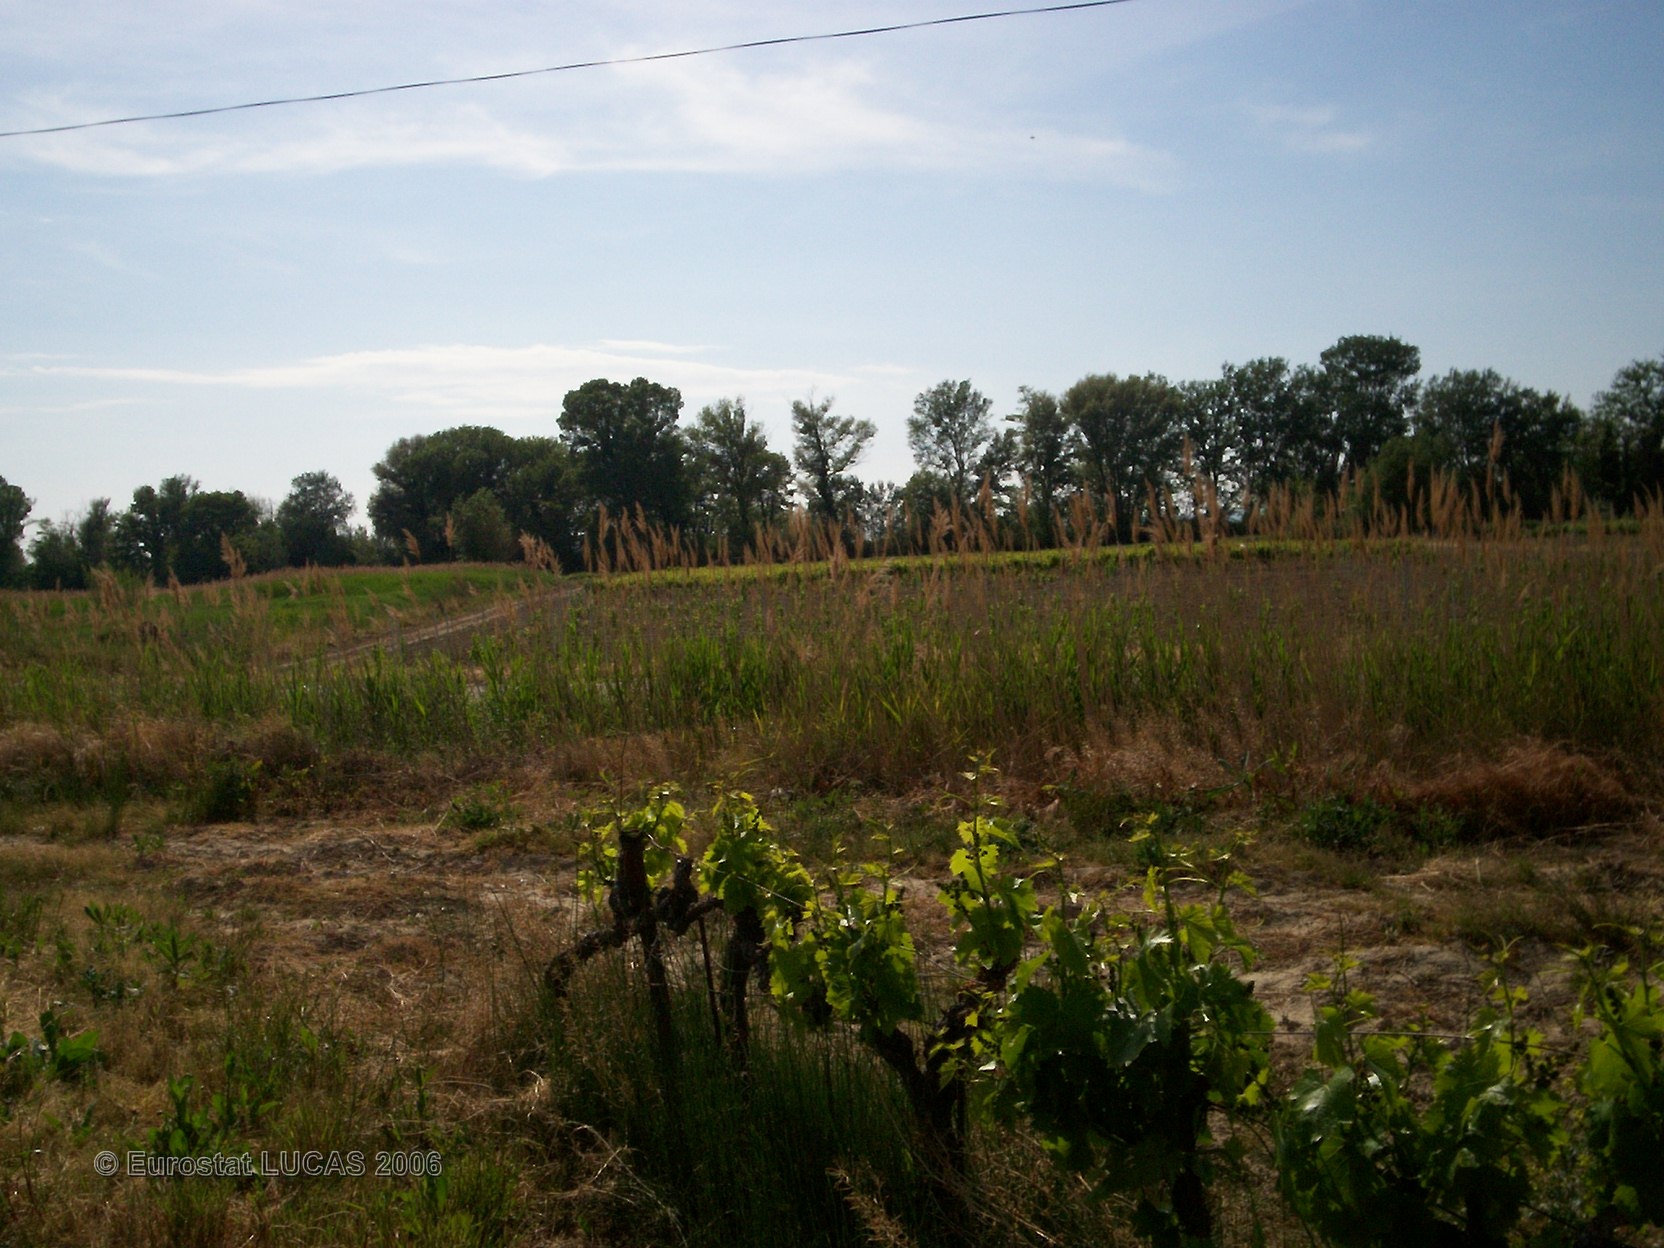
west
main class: Cropland
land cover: Vineyards
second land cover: Grassland with sparse tree/shrub cover
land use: Agriculture (excluding fallow land and kitchen gardens)
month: May
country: FR
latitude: 44.2990
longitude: 4.9313
